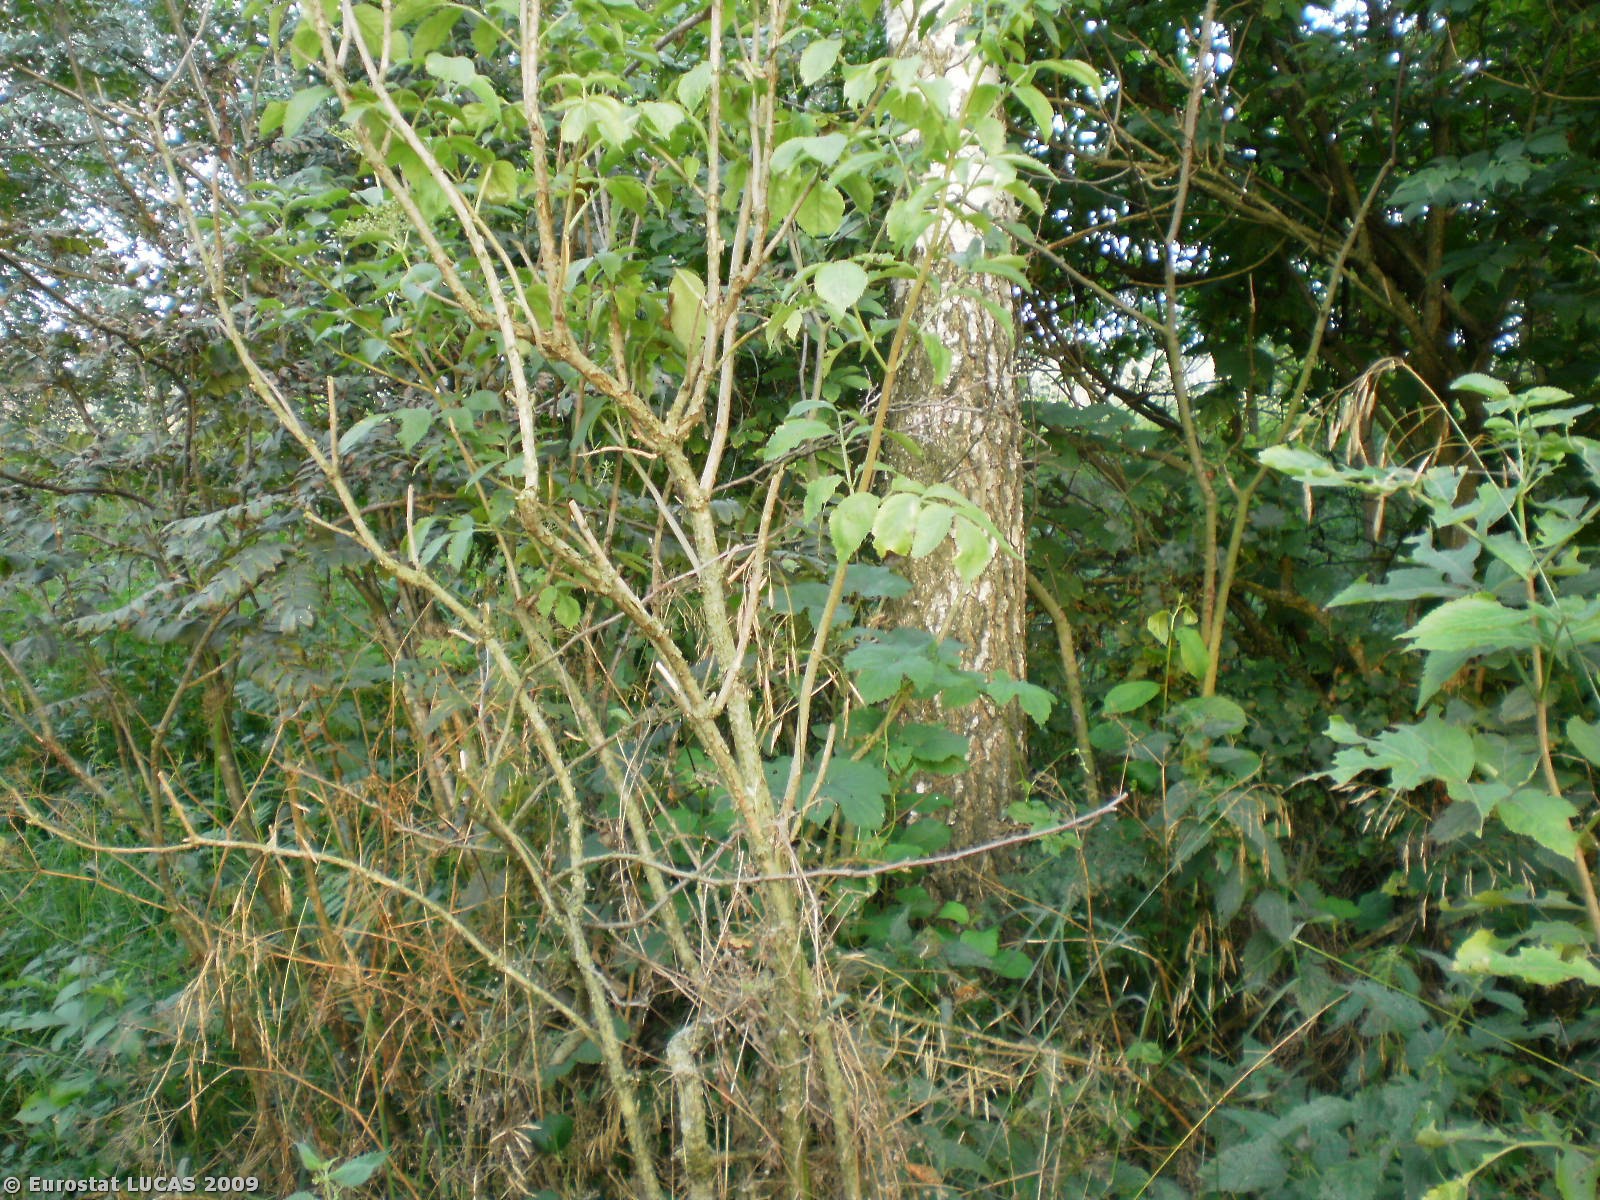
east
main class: Woodland
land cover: Broadleaved woodland
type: mesophytic deciduous forest
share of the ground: 25 - 50 %
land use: Unused
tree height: > 5 m
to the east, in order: Broadleaved woodland; Spontaneously vegetated surfaces; Grassland without tree/shrub cover; Ditches and canals; Abandoned hedges; Grassland without tree/shrub cover
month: July
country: PL
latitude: 53.4420
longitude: 21.0187
